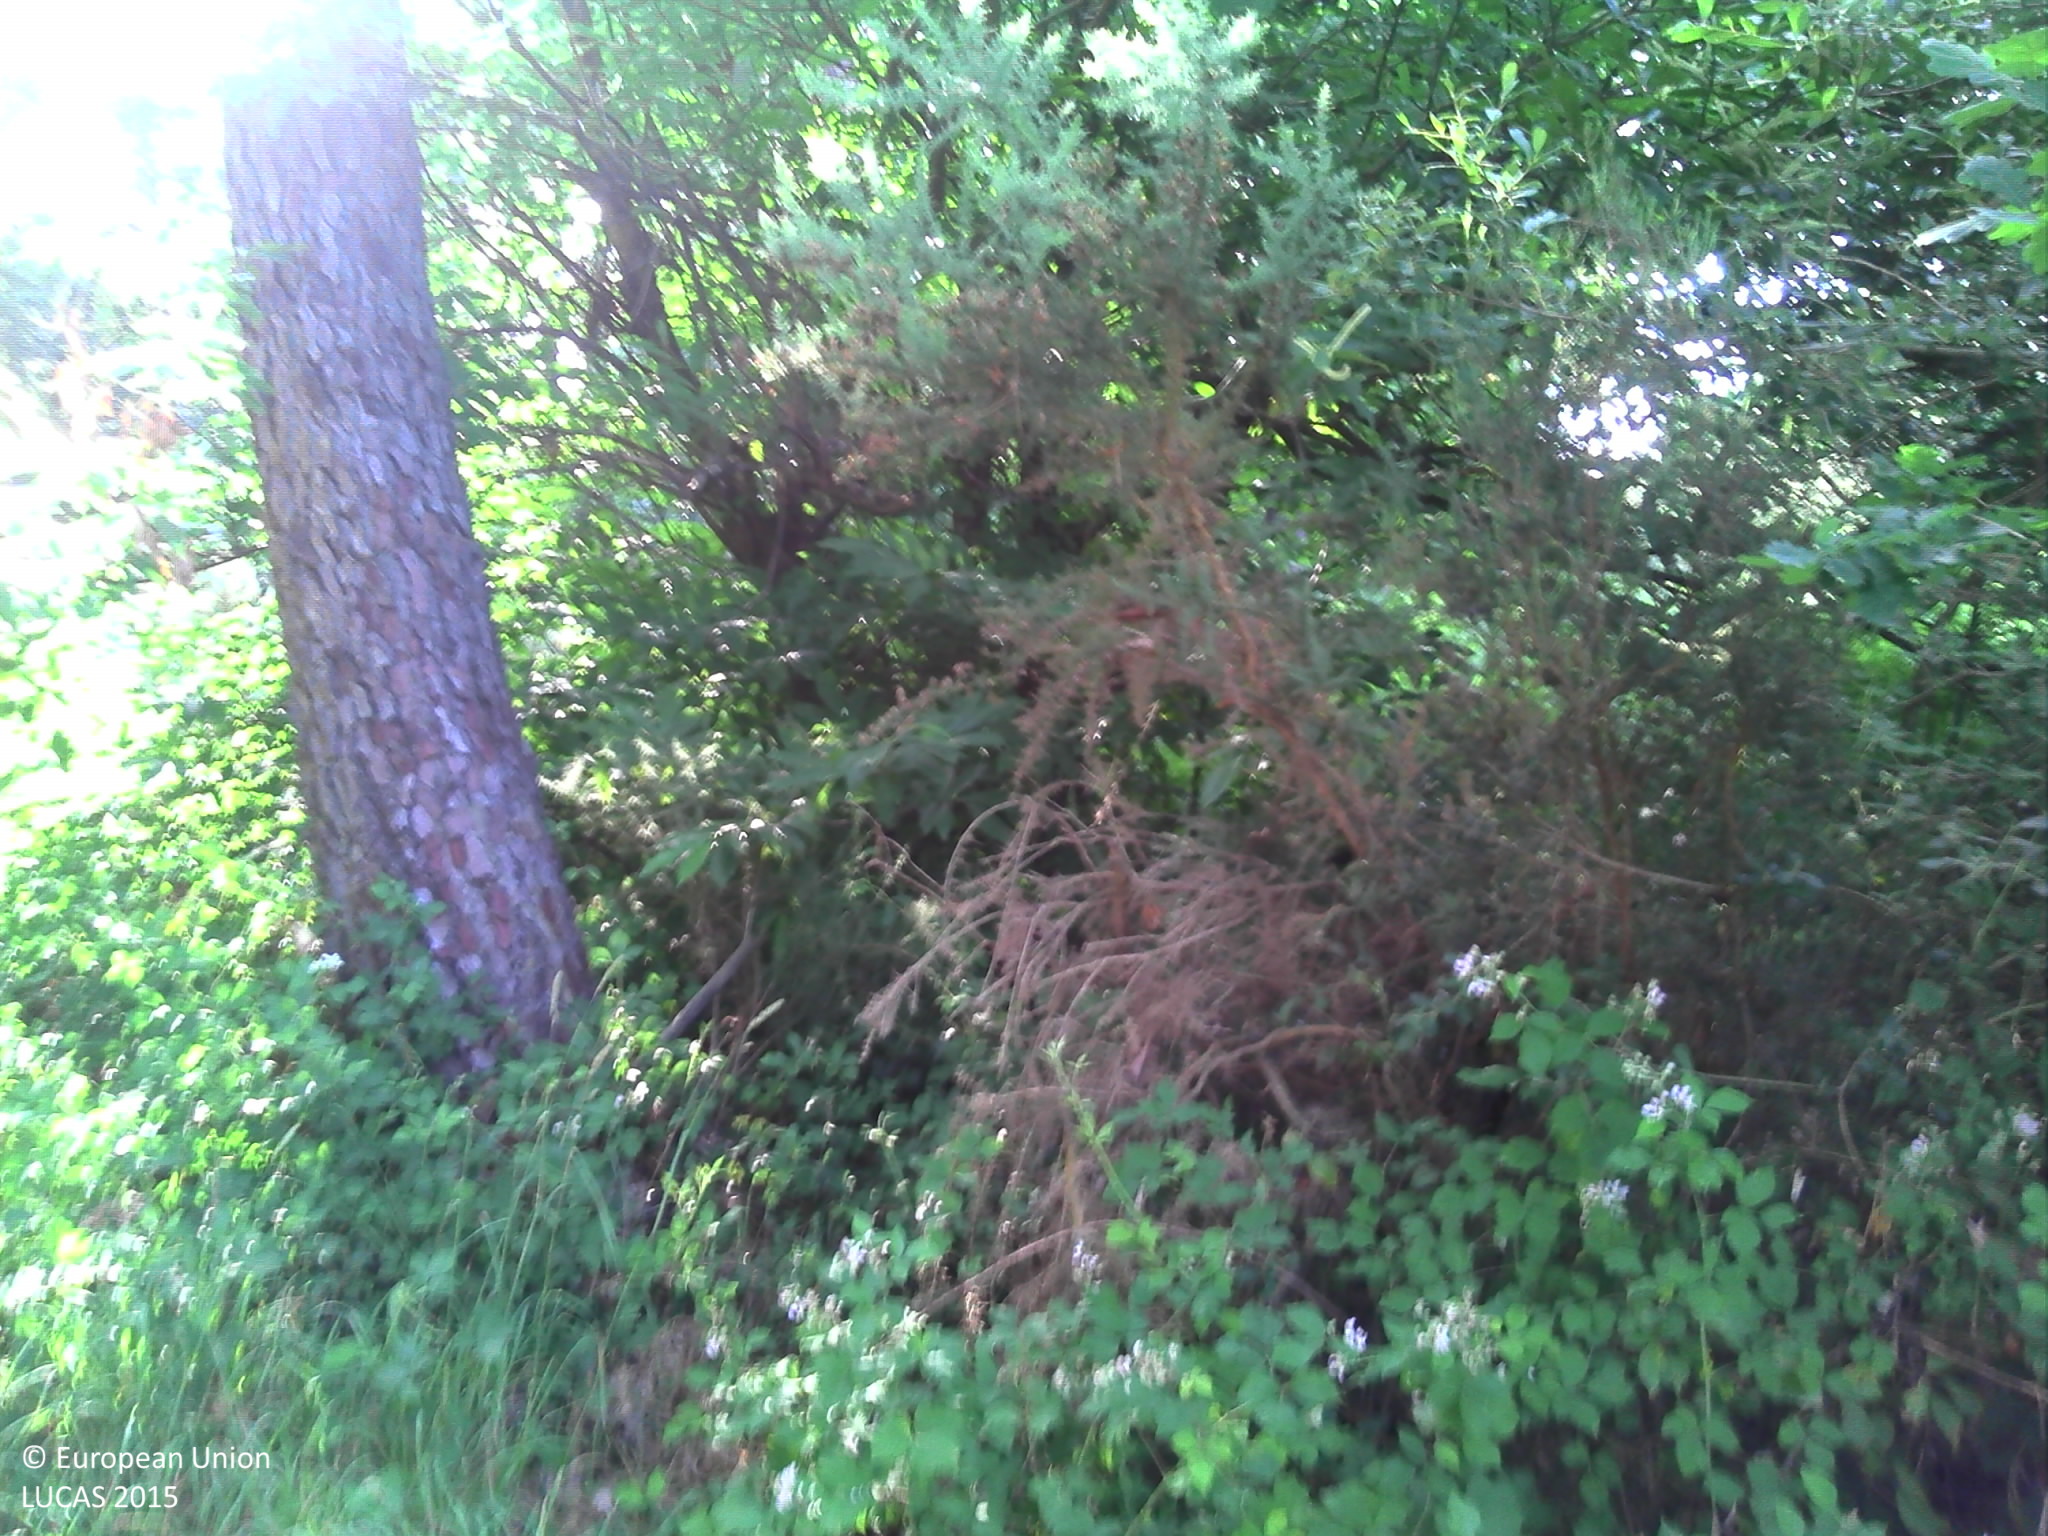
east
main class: Woodland
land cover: Pine dominated mixed woodland
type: hemiboreal forest and nemoral coniferous forest and mixed broadleaved-coniferous forest
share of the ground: > 75 %
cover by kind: broadleaved forest trees 55 %, coniferous forest trees 25 %, shrubs 10 %, herbaceous plants 10 %
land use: Forestry
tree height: > 5 m
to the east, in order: Pine dominated mixed woodland; Paved roads, cycling and walking lanes; Broadleaved woodland; Tracks; Broadleaved woodland
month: June
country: FR
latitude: 46.5231
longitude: 0.2689
